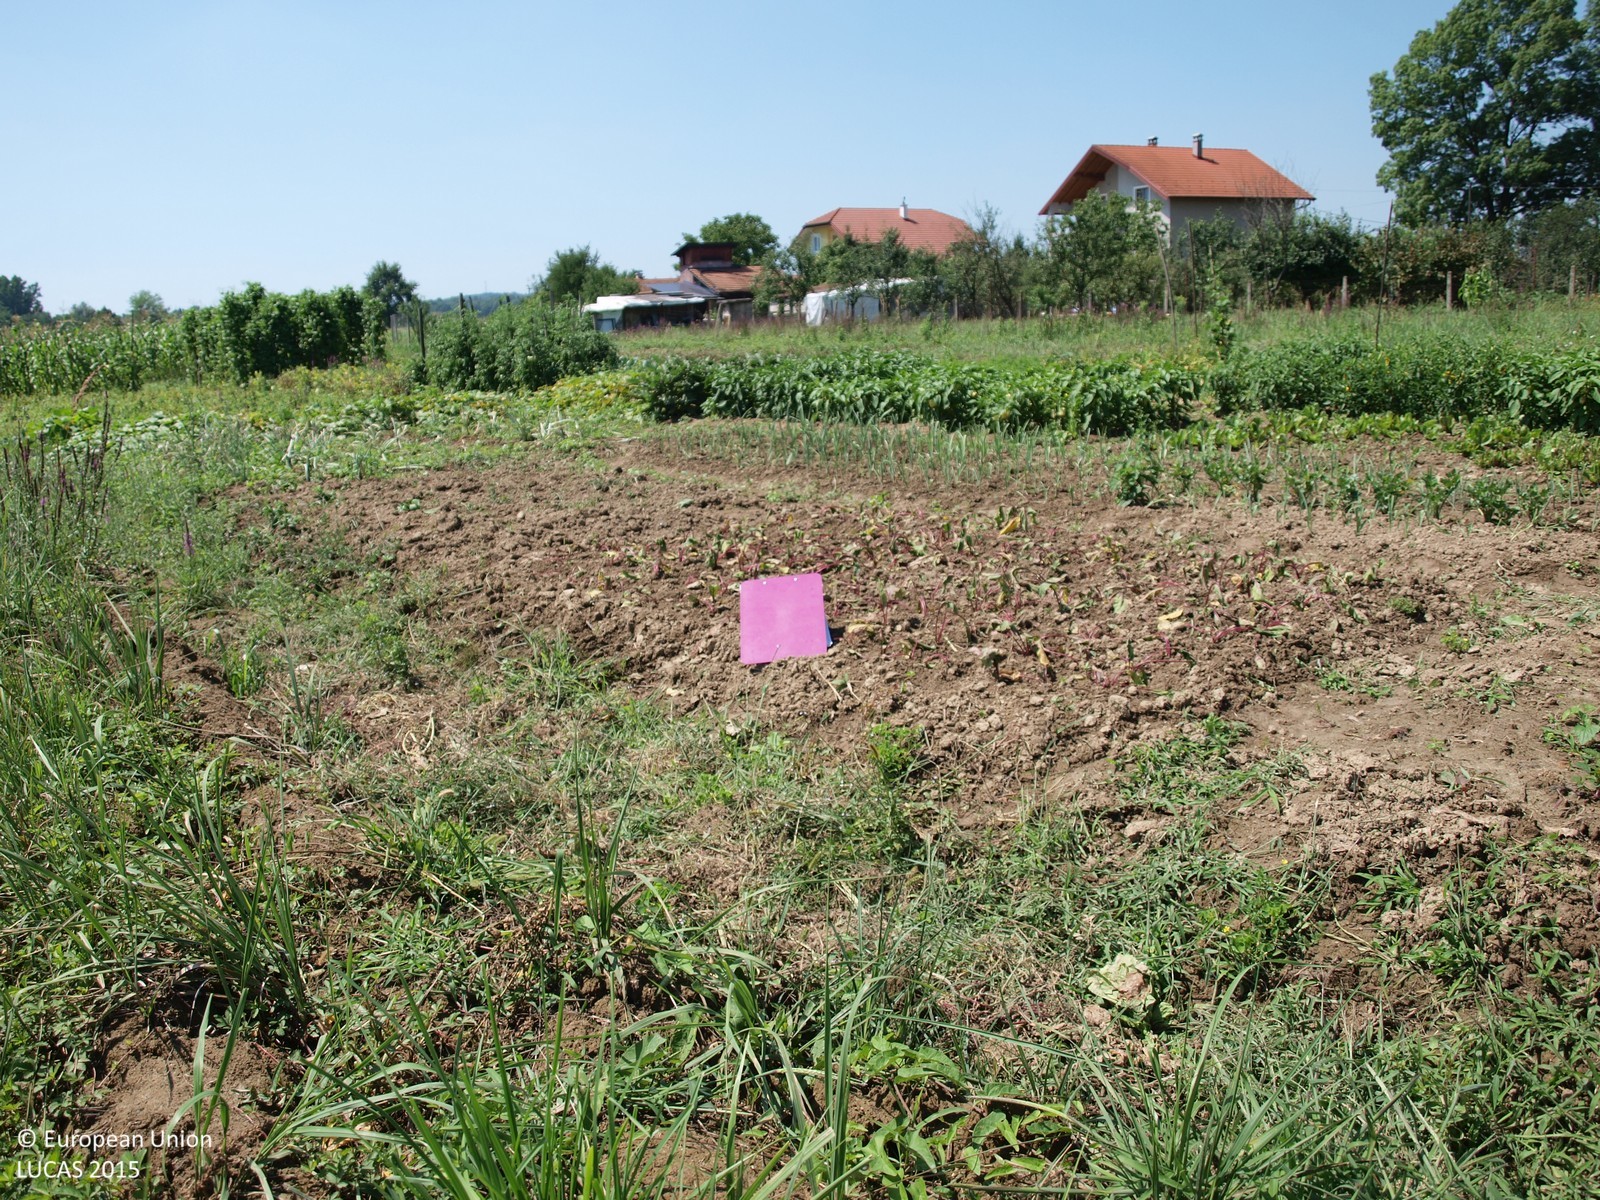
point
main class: Cropland
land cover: Other root crops
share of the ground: > 75 %
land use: Kitchen garden
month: August
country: HR
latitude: 45.8421
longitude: 16.2692
